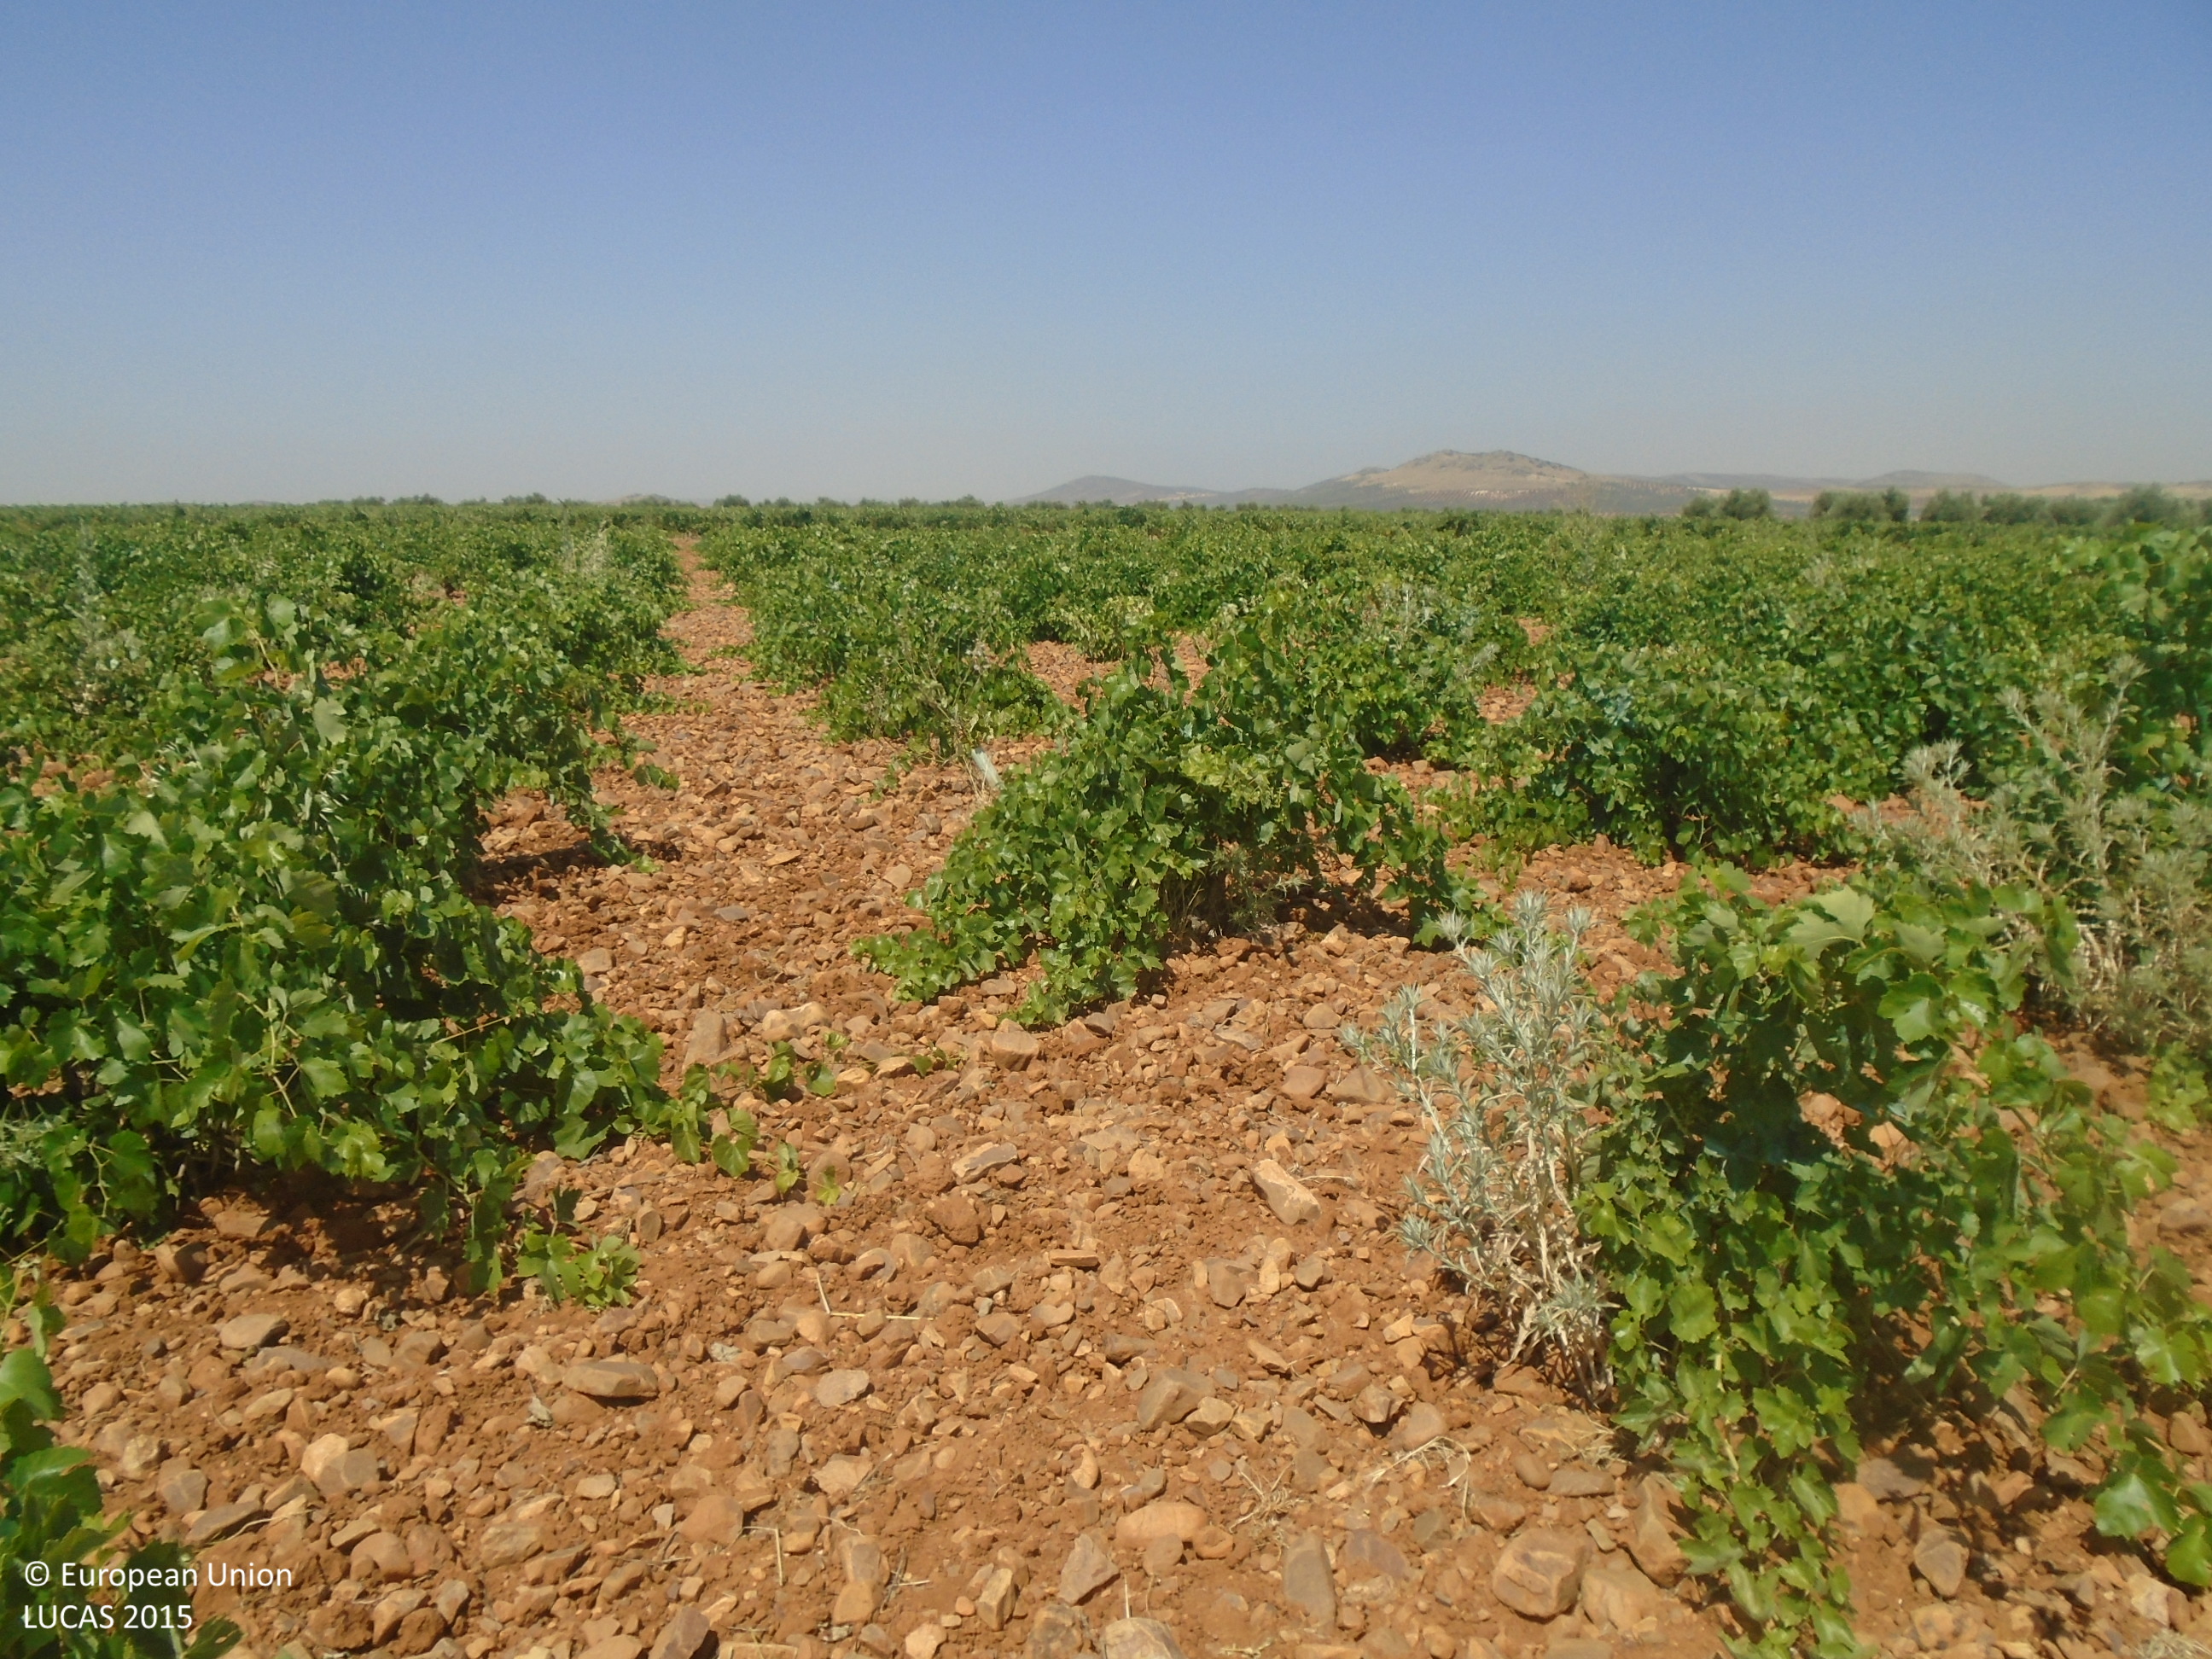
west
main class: Cropland
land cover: Vineyards
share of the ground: 10 - 25 %
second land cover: Other bare soil
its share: > 75 %
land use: Agriculture (excluding fallow land and kitchen gardens)
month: July
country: ES
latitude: 39.4218
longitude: -3.6254
